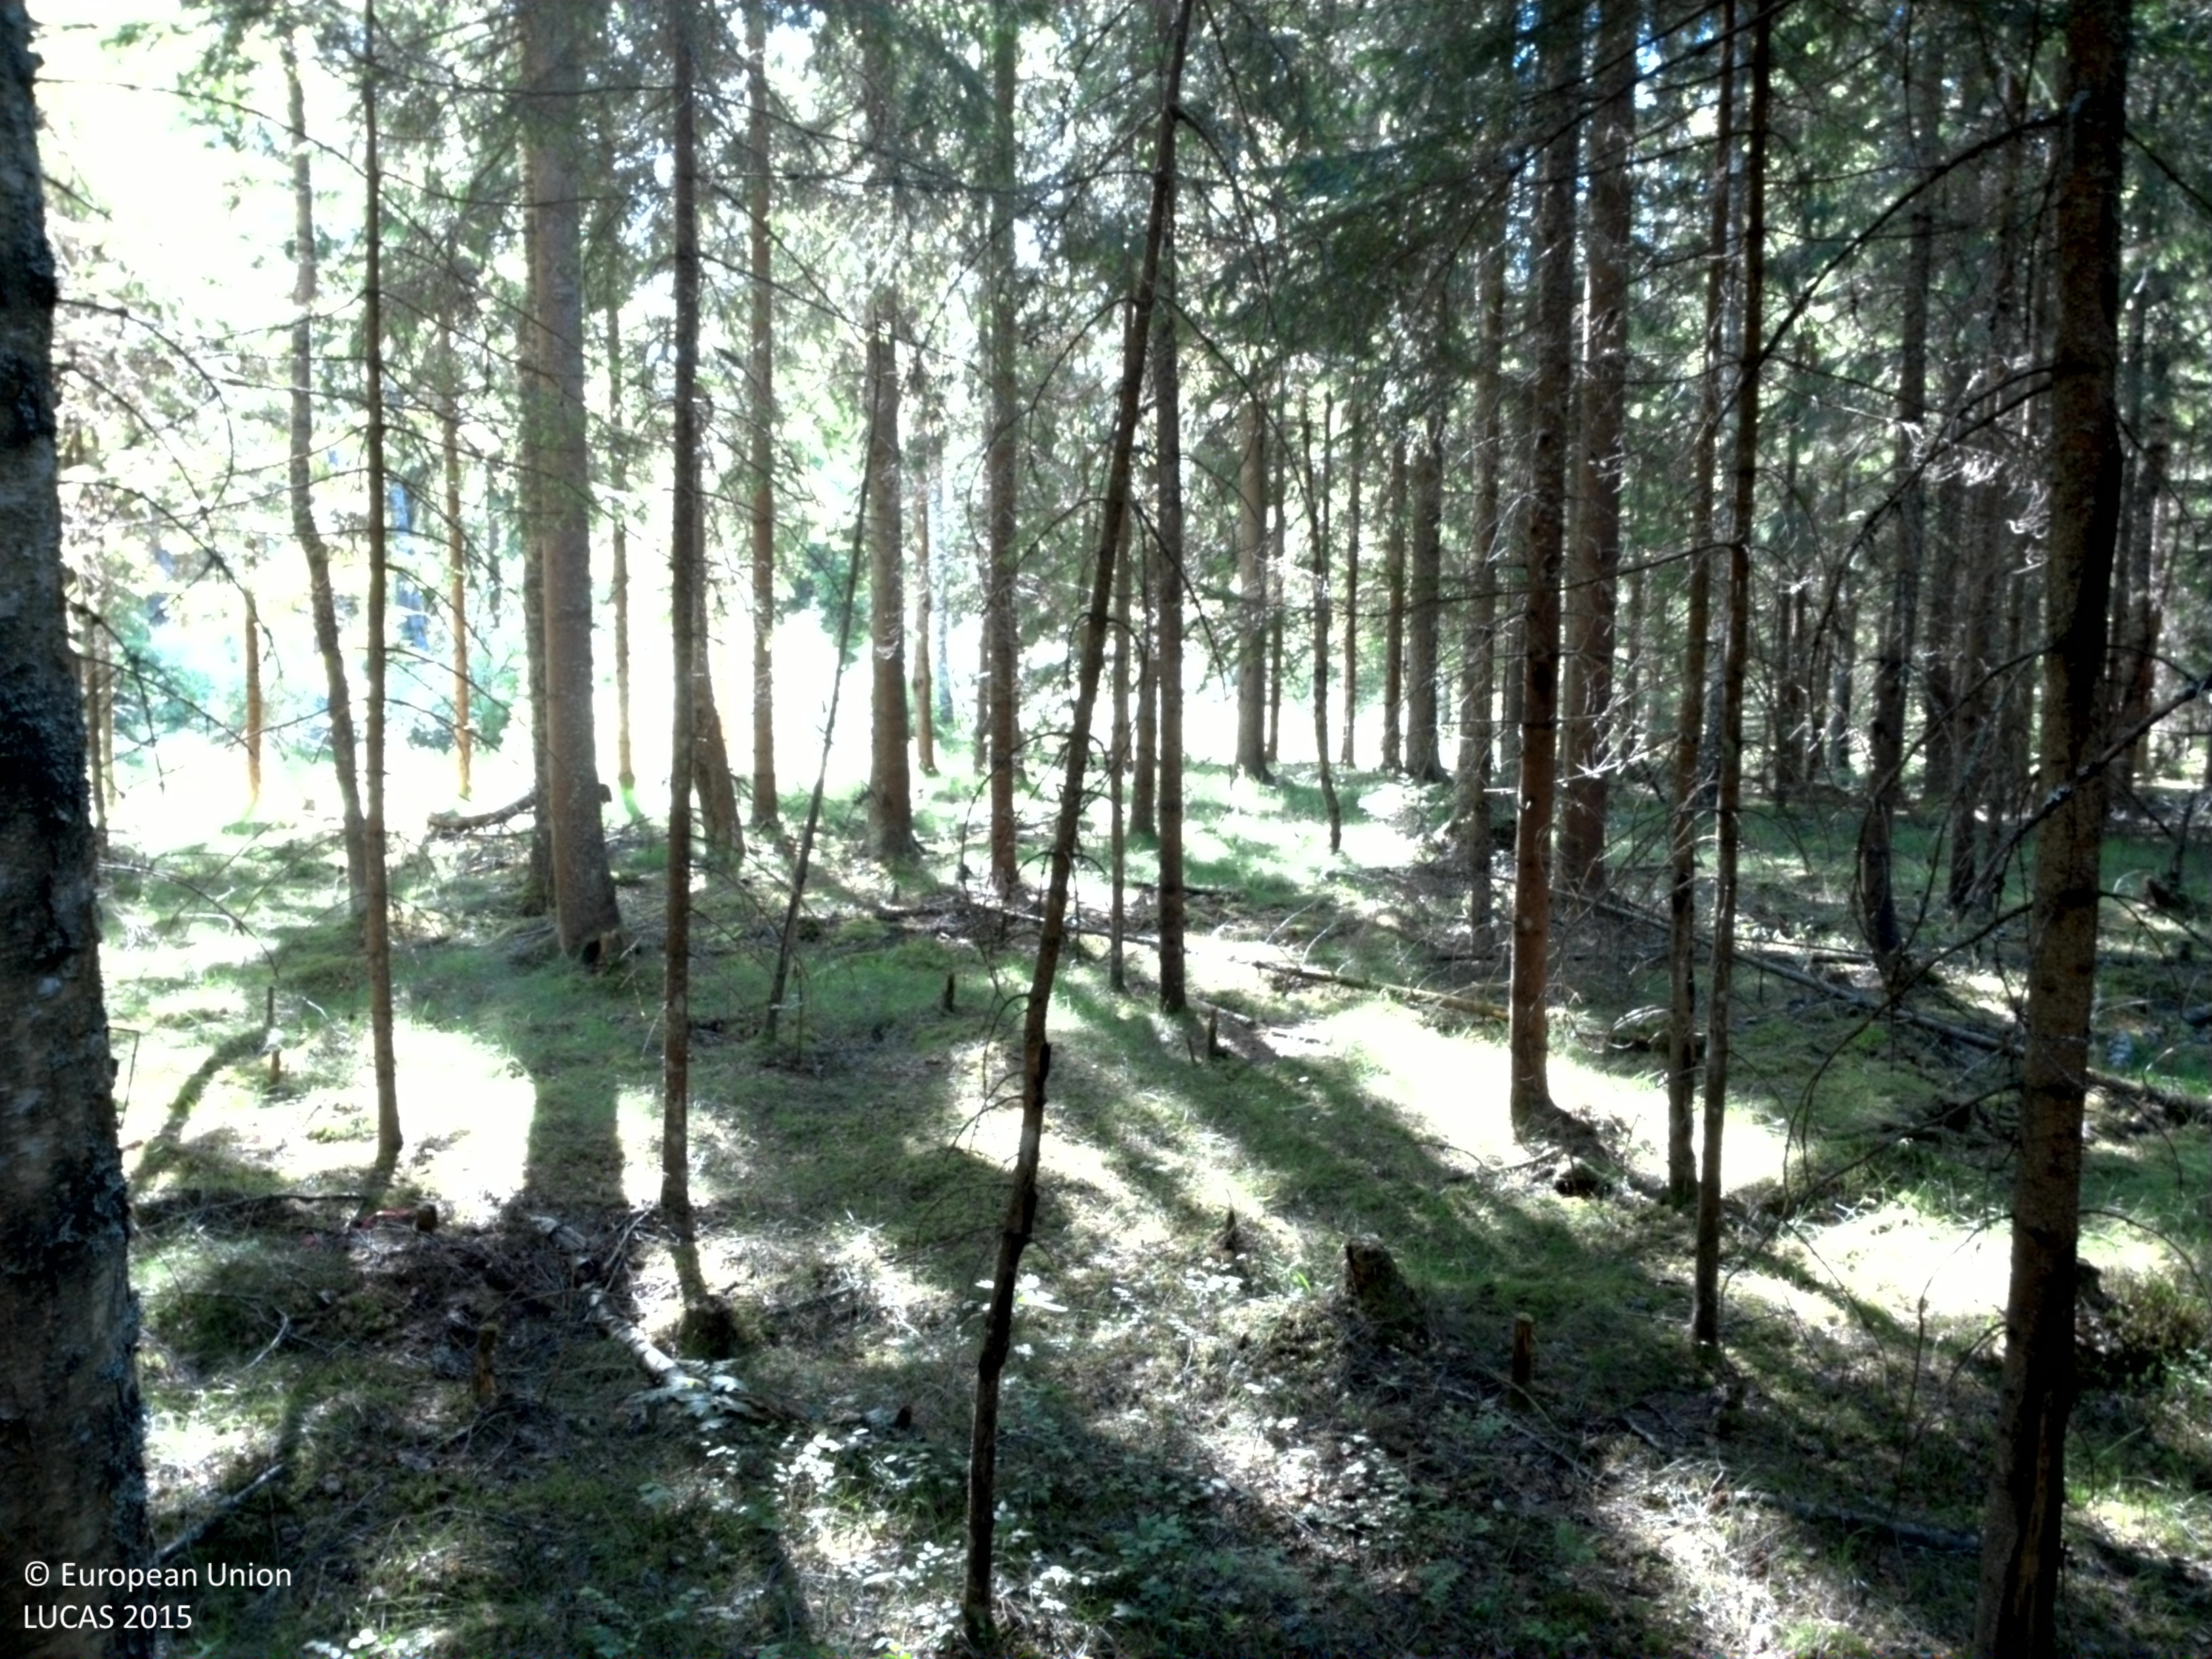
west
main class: Woodland
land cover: Spruce dominated coniferous woodland
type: boreal forest
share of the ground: > 75 %
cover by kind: coniferous forest trees 90 %, broadleaved forest trees 5 %, lichens and mosses 5 %
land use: Forestry
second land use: Community services
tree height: > 5 m
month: June
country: SE
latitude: 58.5941
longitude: 14.5183
